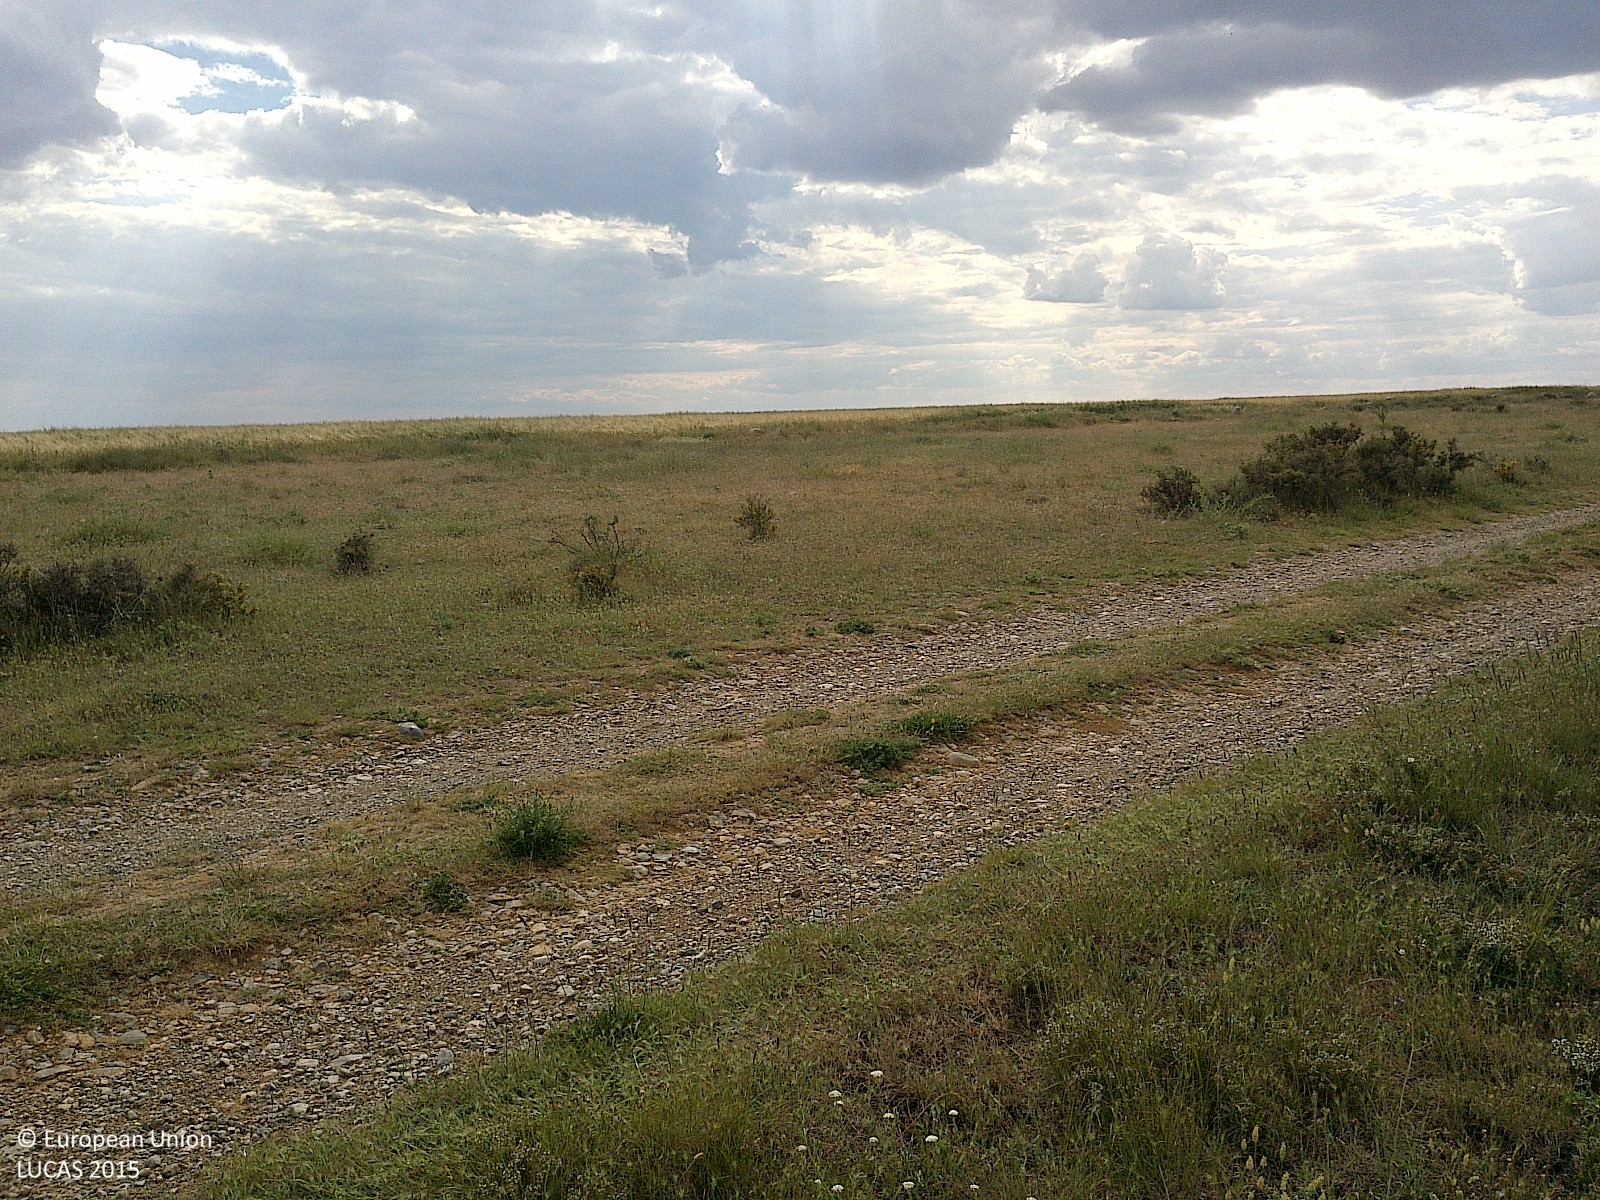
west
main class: Grassland
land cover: Grassland without tree/shrub cover
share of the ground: > 75 %
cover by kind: herbaceous plants 75 %, consolidated bare surface 15 %, shrubs 5 %, lichens and mosses 5 %
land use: Semi-natural and natural areas not in use
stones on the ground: < 10 %
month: June
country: ES
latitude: 41.6968
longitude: -2.1822
